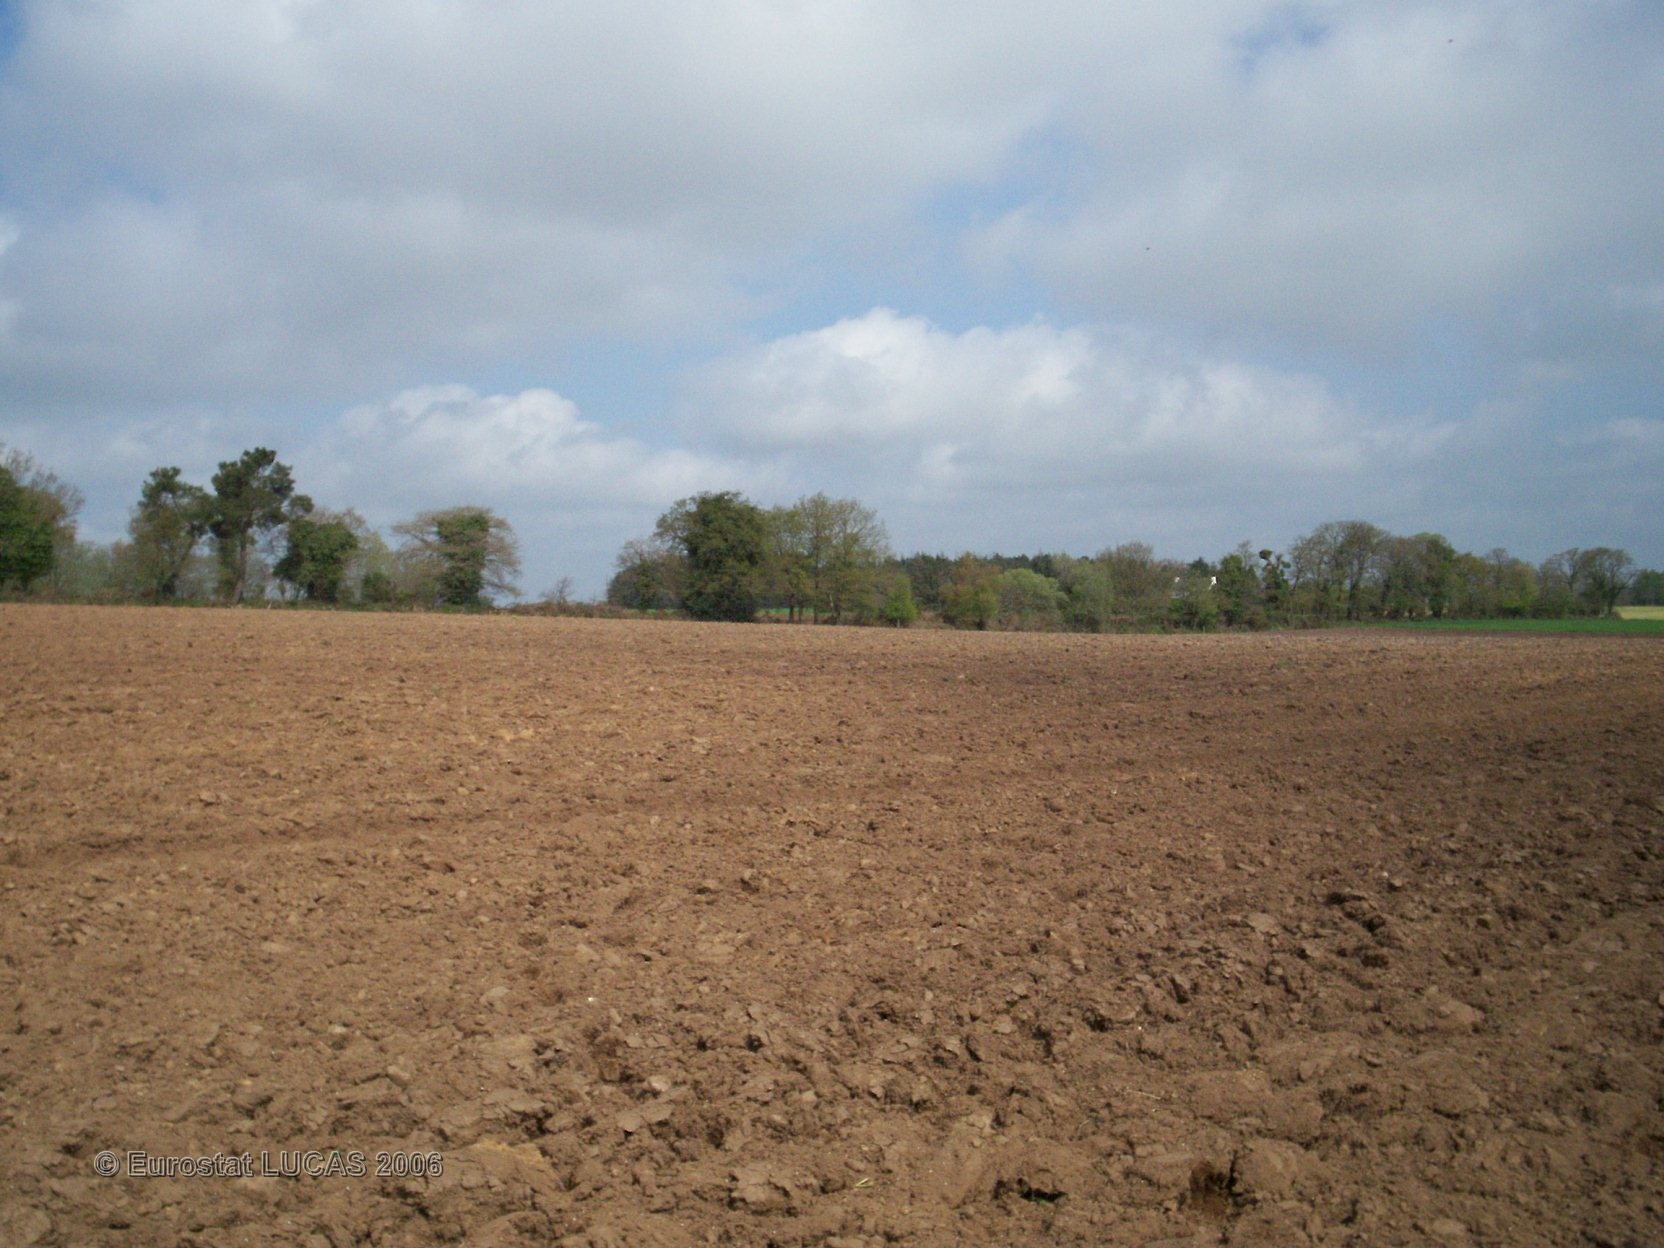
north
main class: Cropland
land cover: Maize
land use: Agriculture (excluding fallow land and kitchen gardens)
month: May
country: FR
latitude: 47.8030
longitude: -2.7876
